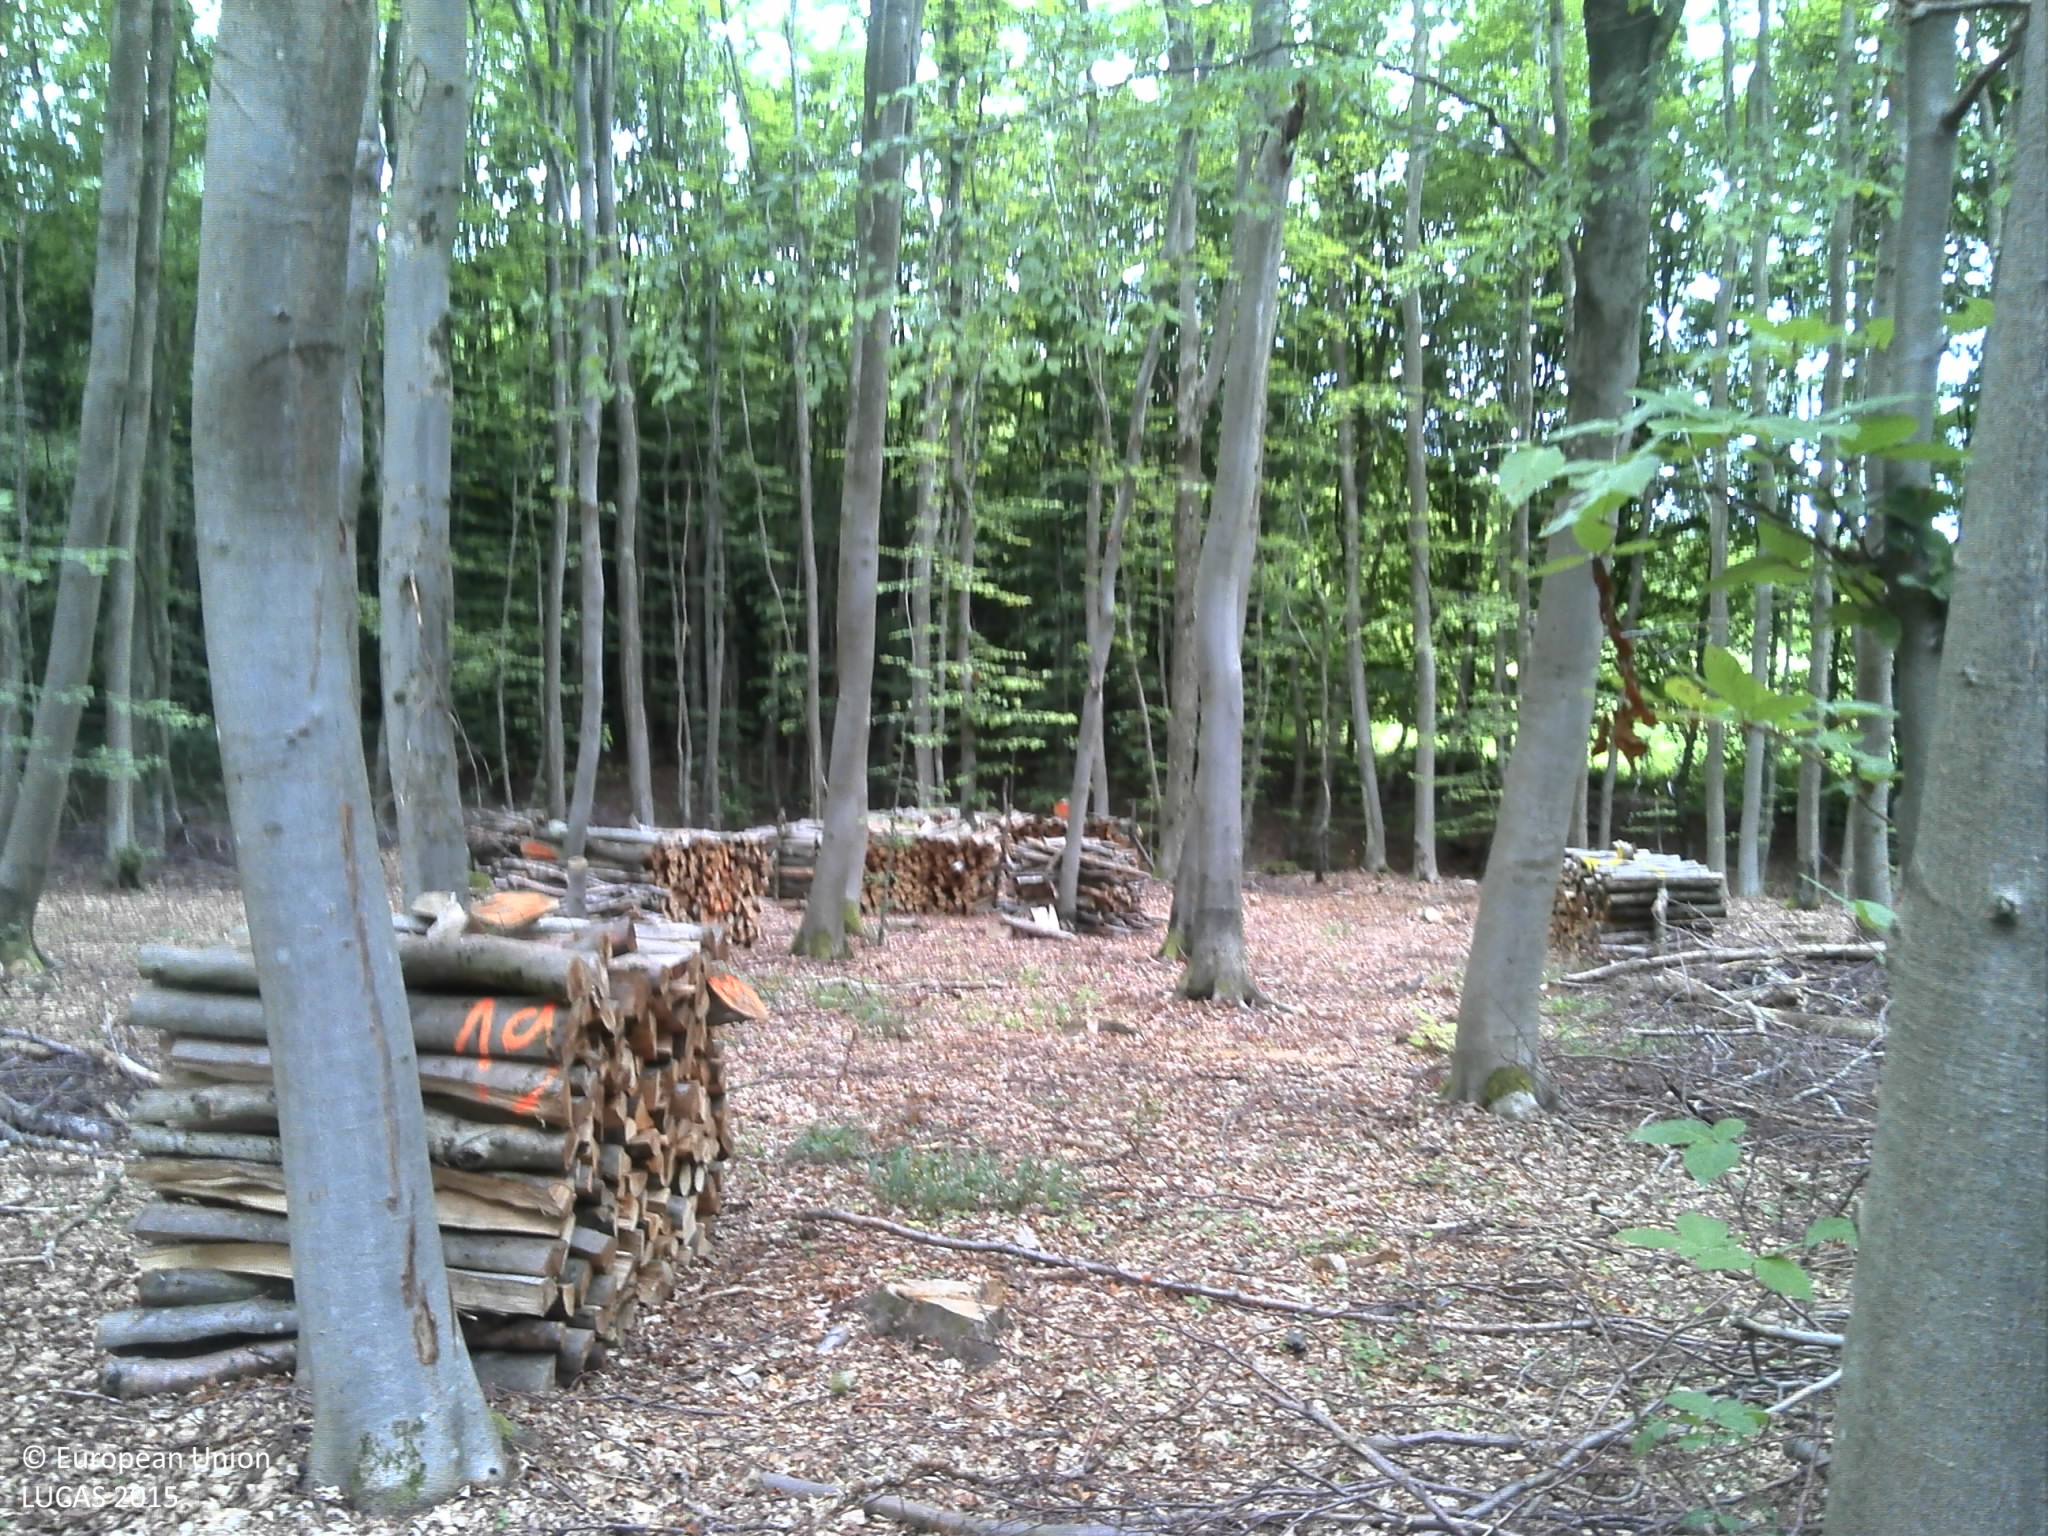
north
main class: Woodland
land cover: Broadleaved woodland
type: beech forest
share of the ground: > 75 %
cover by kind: broadleaved forest trees 100 %
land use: Forestry
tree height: > 5 m
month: July
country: FR
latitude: 49.3741
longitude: 6.4879
